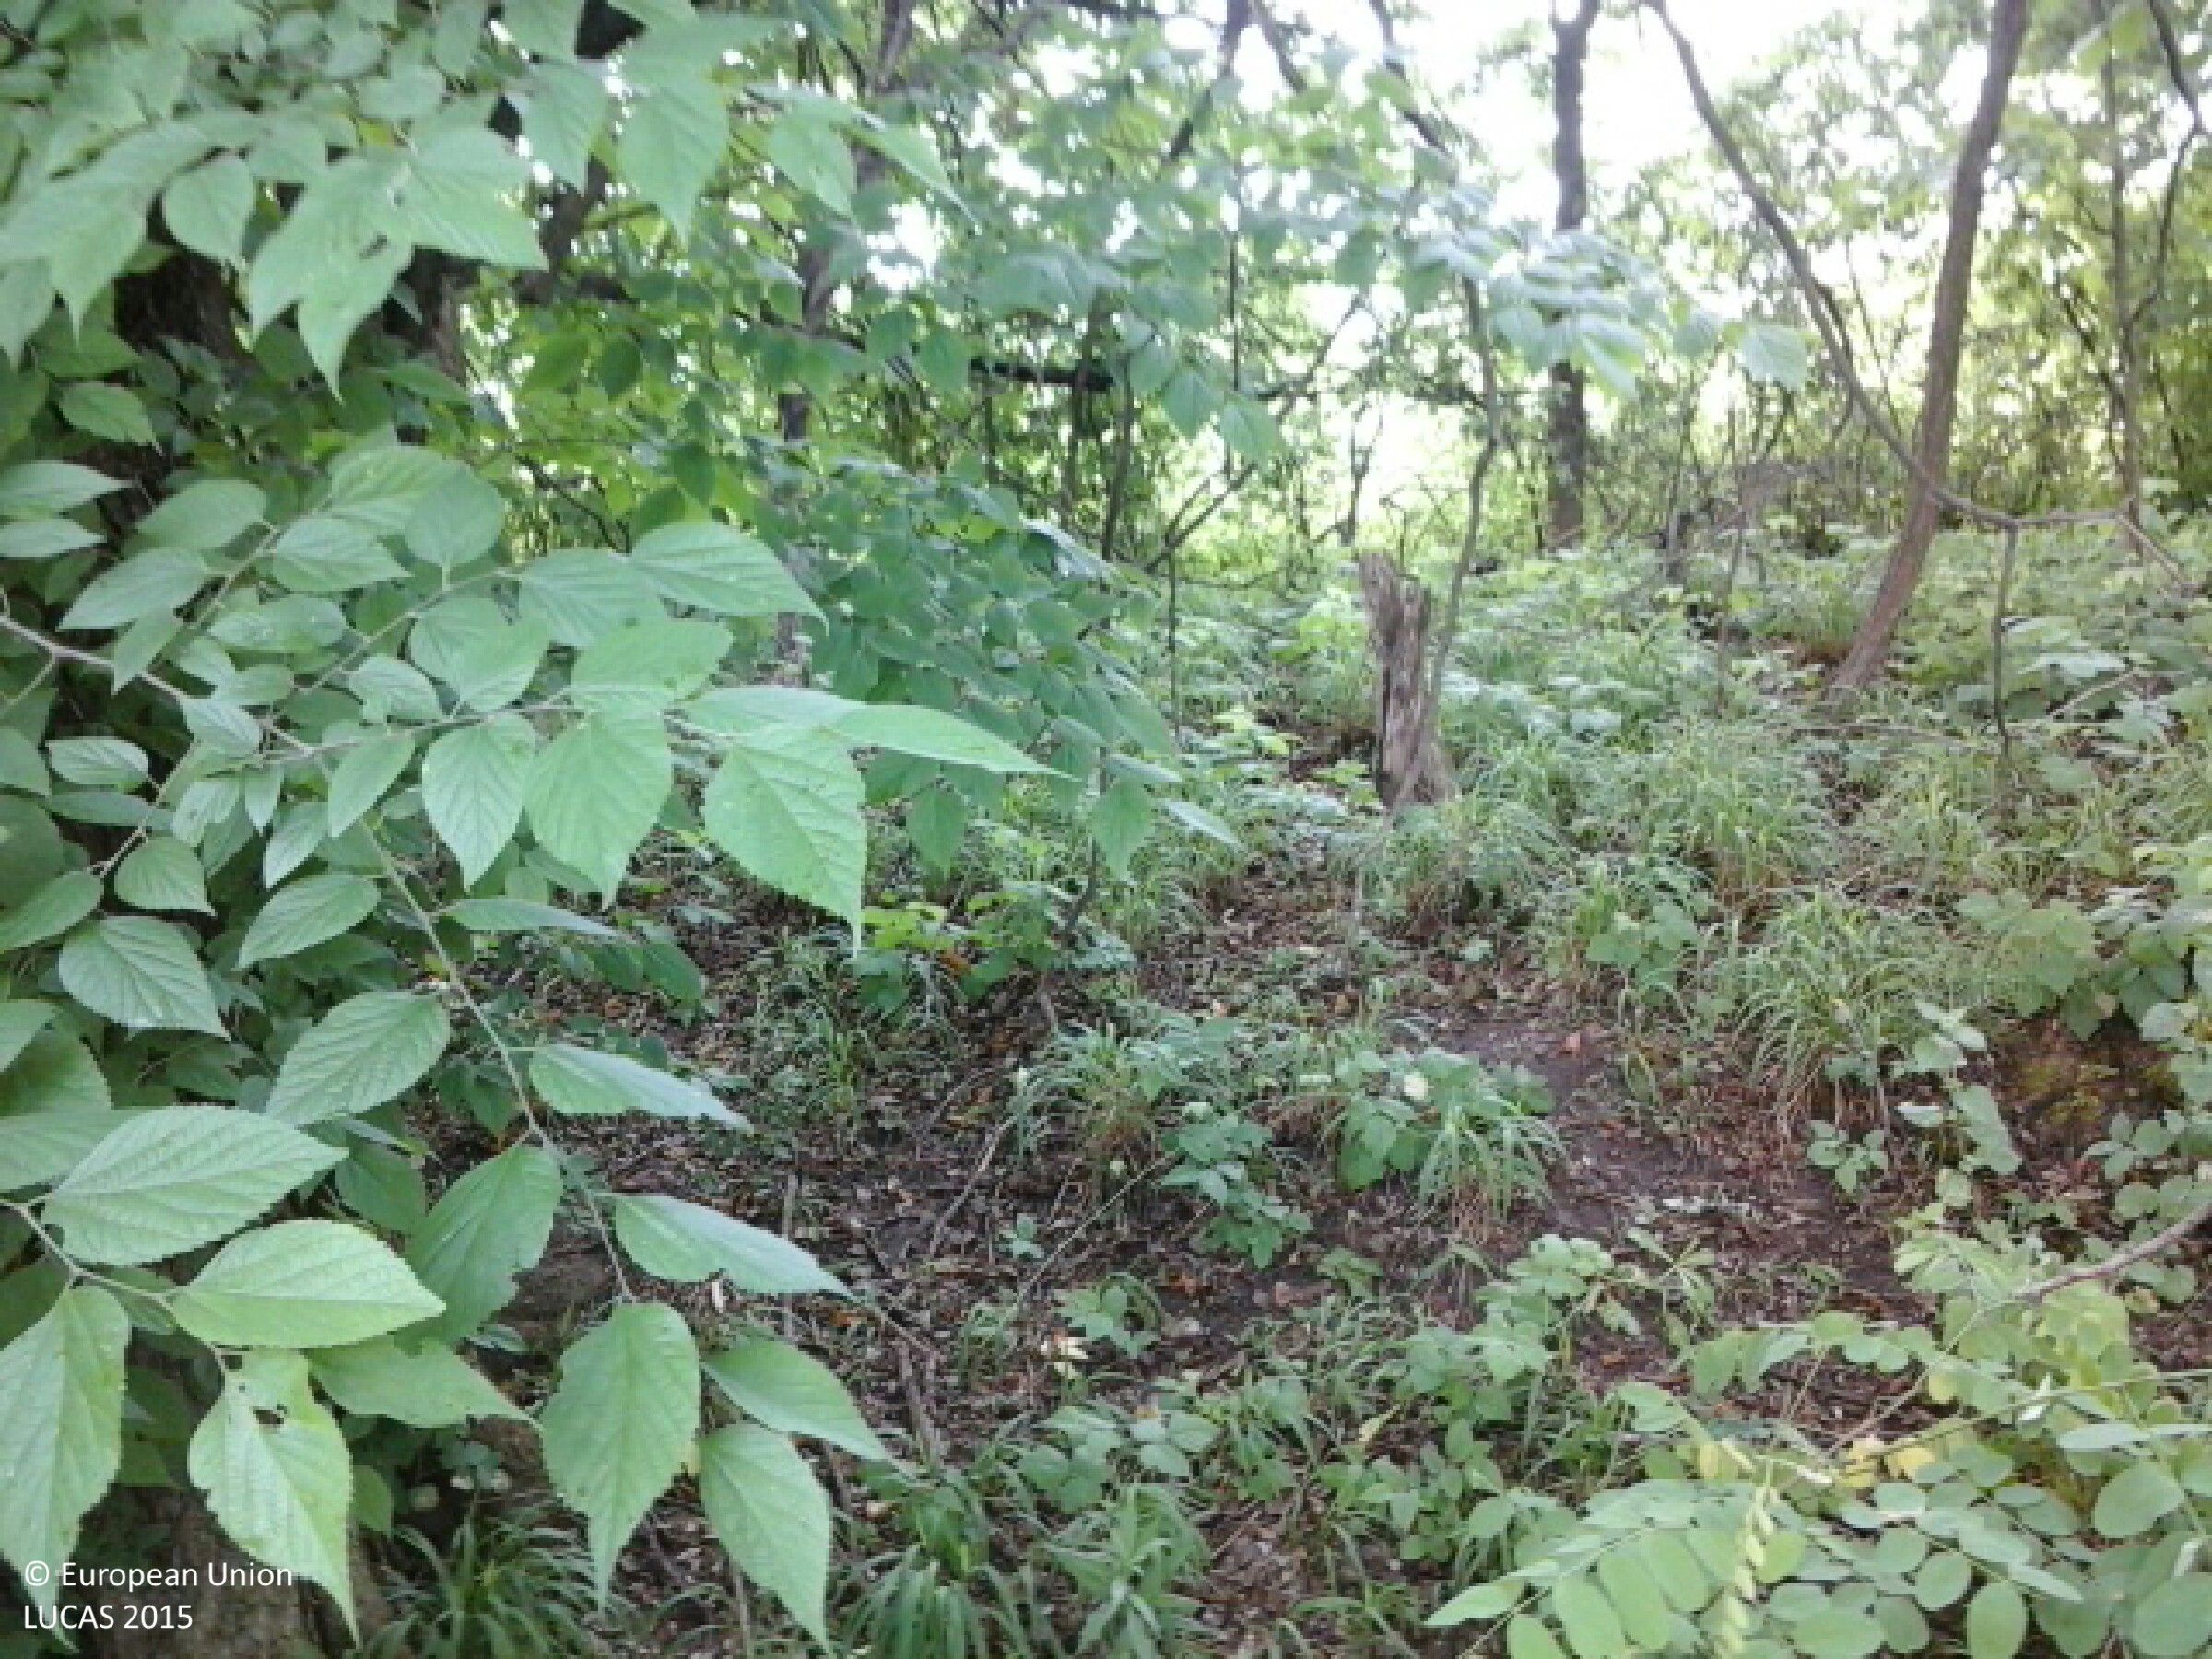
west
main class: Woodland
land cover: Broadleaved woodland
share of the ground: > 75 %
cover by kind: broadleaved forest trees 90 %, shrubs 5 %, herbaceous plants 5 %
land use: Forestry
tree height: > 5 m
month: June
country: HU
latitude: 47.9341
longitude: 21.7879
